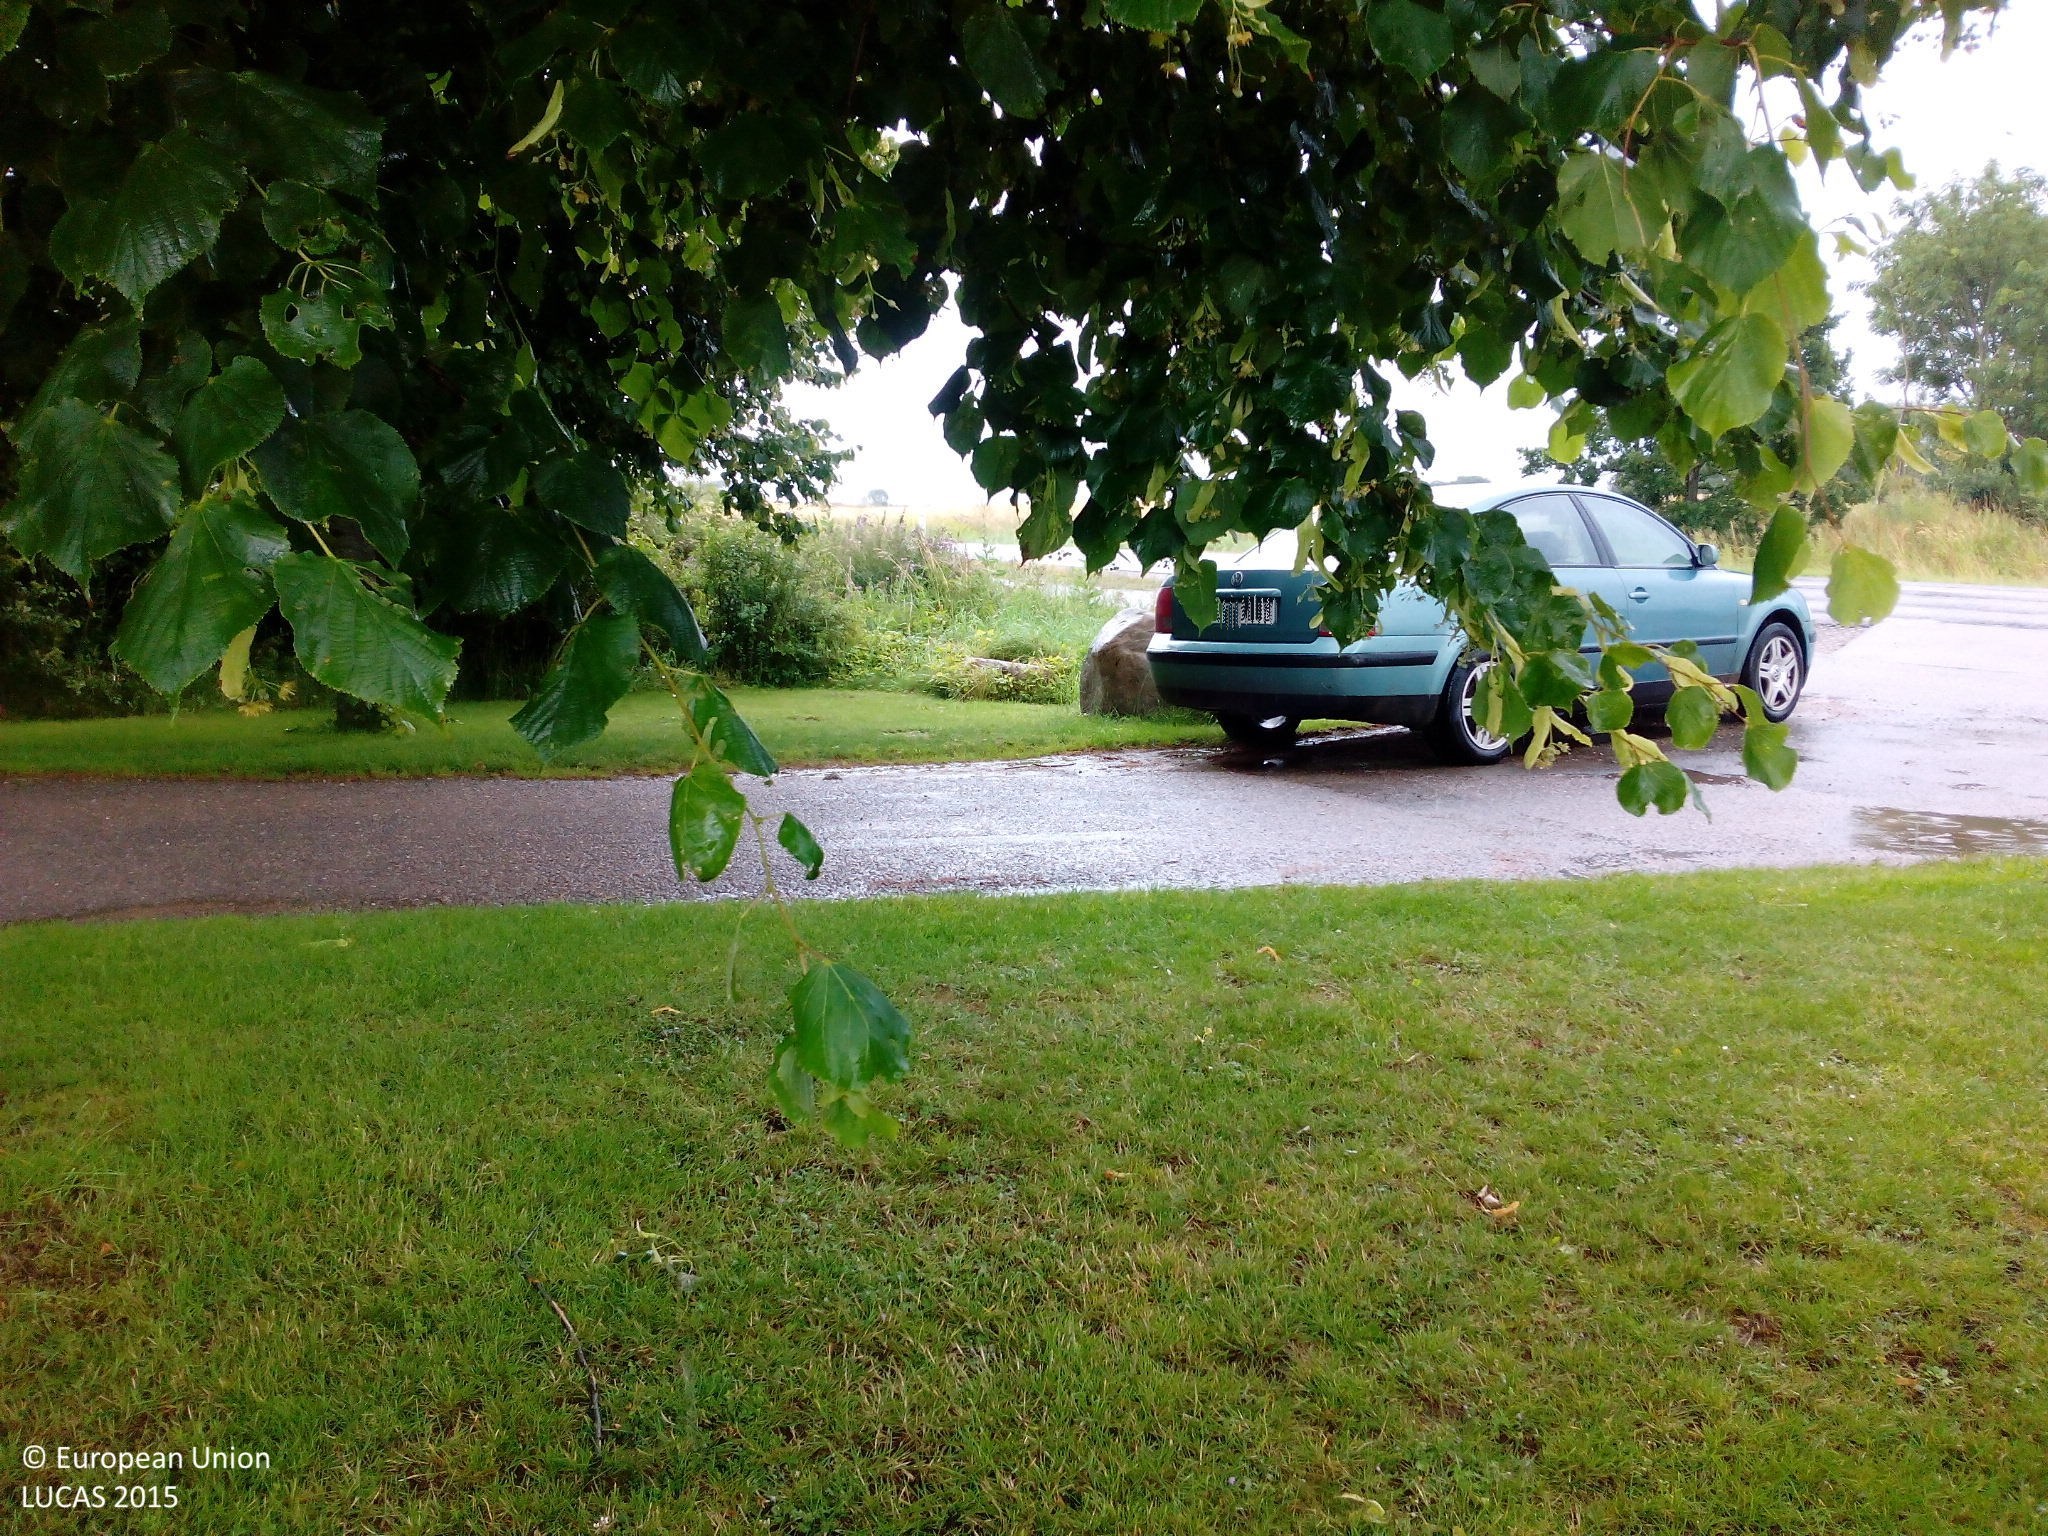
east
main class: Woodland
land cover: Broadleaved woodland
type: acidophilous oak and oak-birch forest
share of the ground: > 75 %
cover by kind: broadleaved forest trees 60 %, herbaceous plants 40 %
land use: Residential
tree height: > 5 m
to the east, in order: Broadleaved woodland; Managed hedges; Fences; Grassland without tree/shrub cover; Fences; Lines of trees; Grass margins; Paved roads, cycling and walking lanes; Lines of trees; Broadleaved woodland; Grass margins; Other fresh vegetables
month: July
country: DK
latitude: 55.8988
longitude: 12.2210
